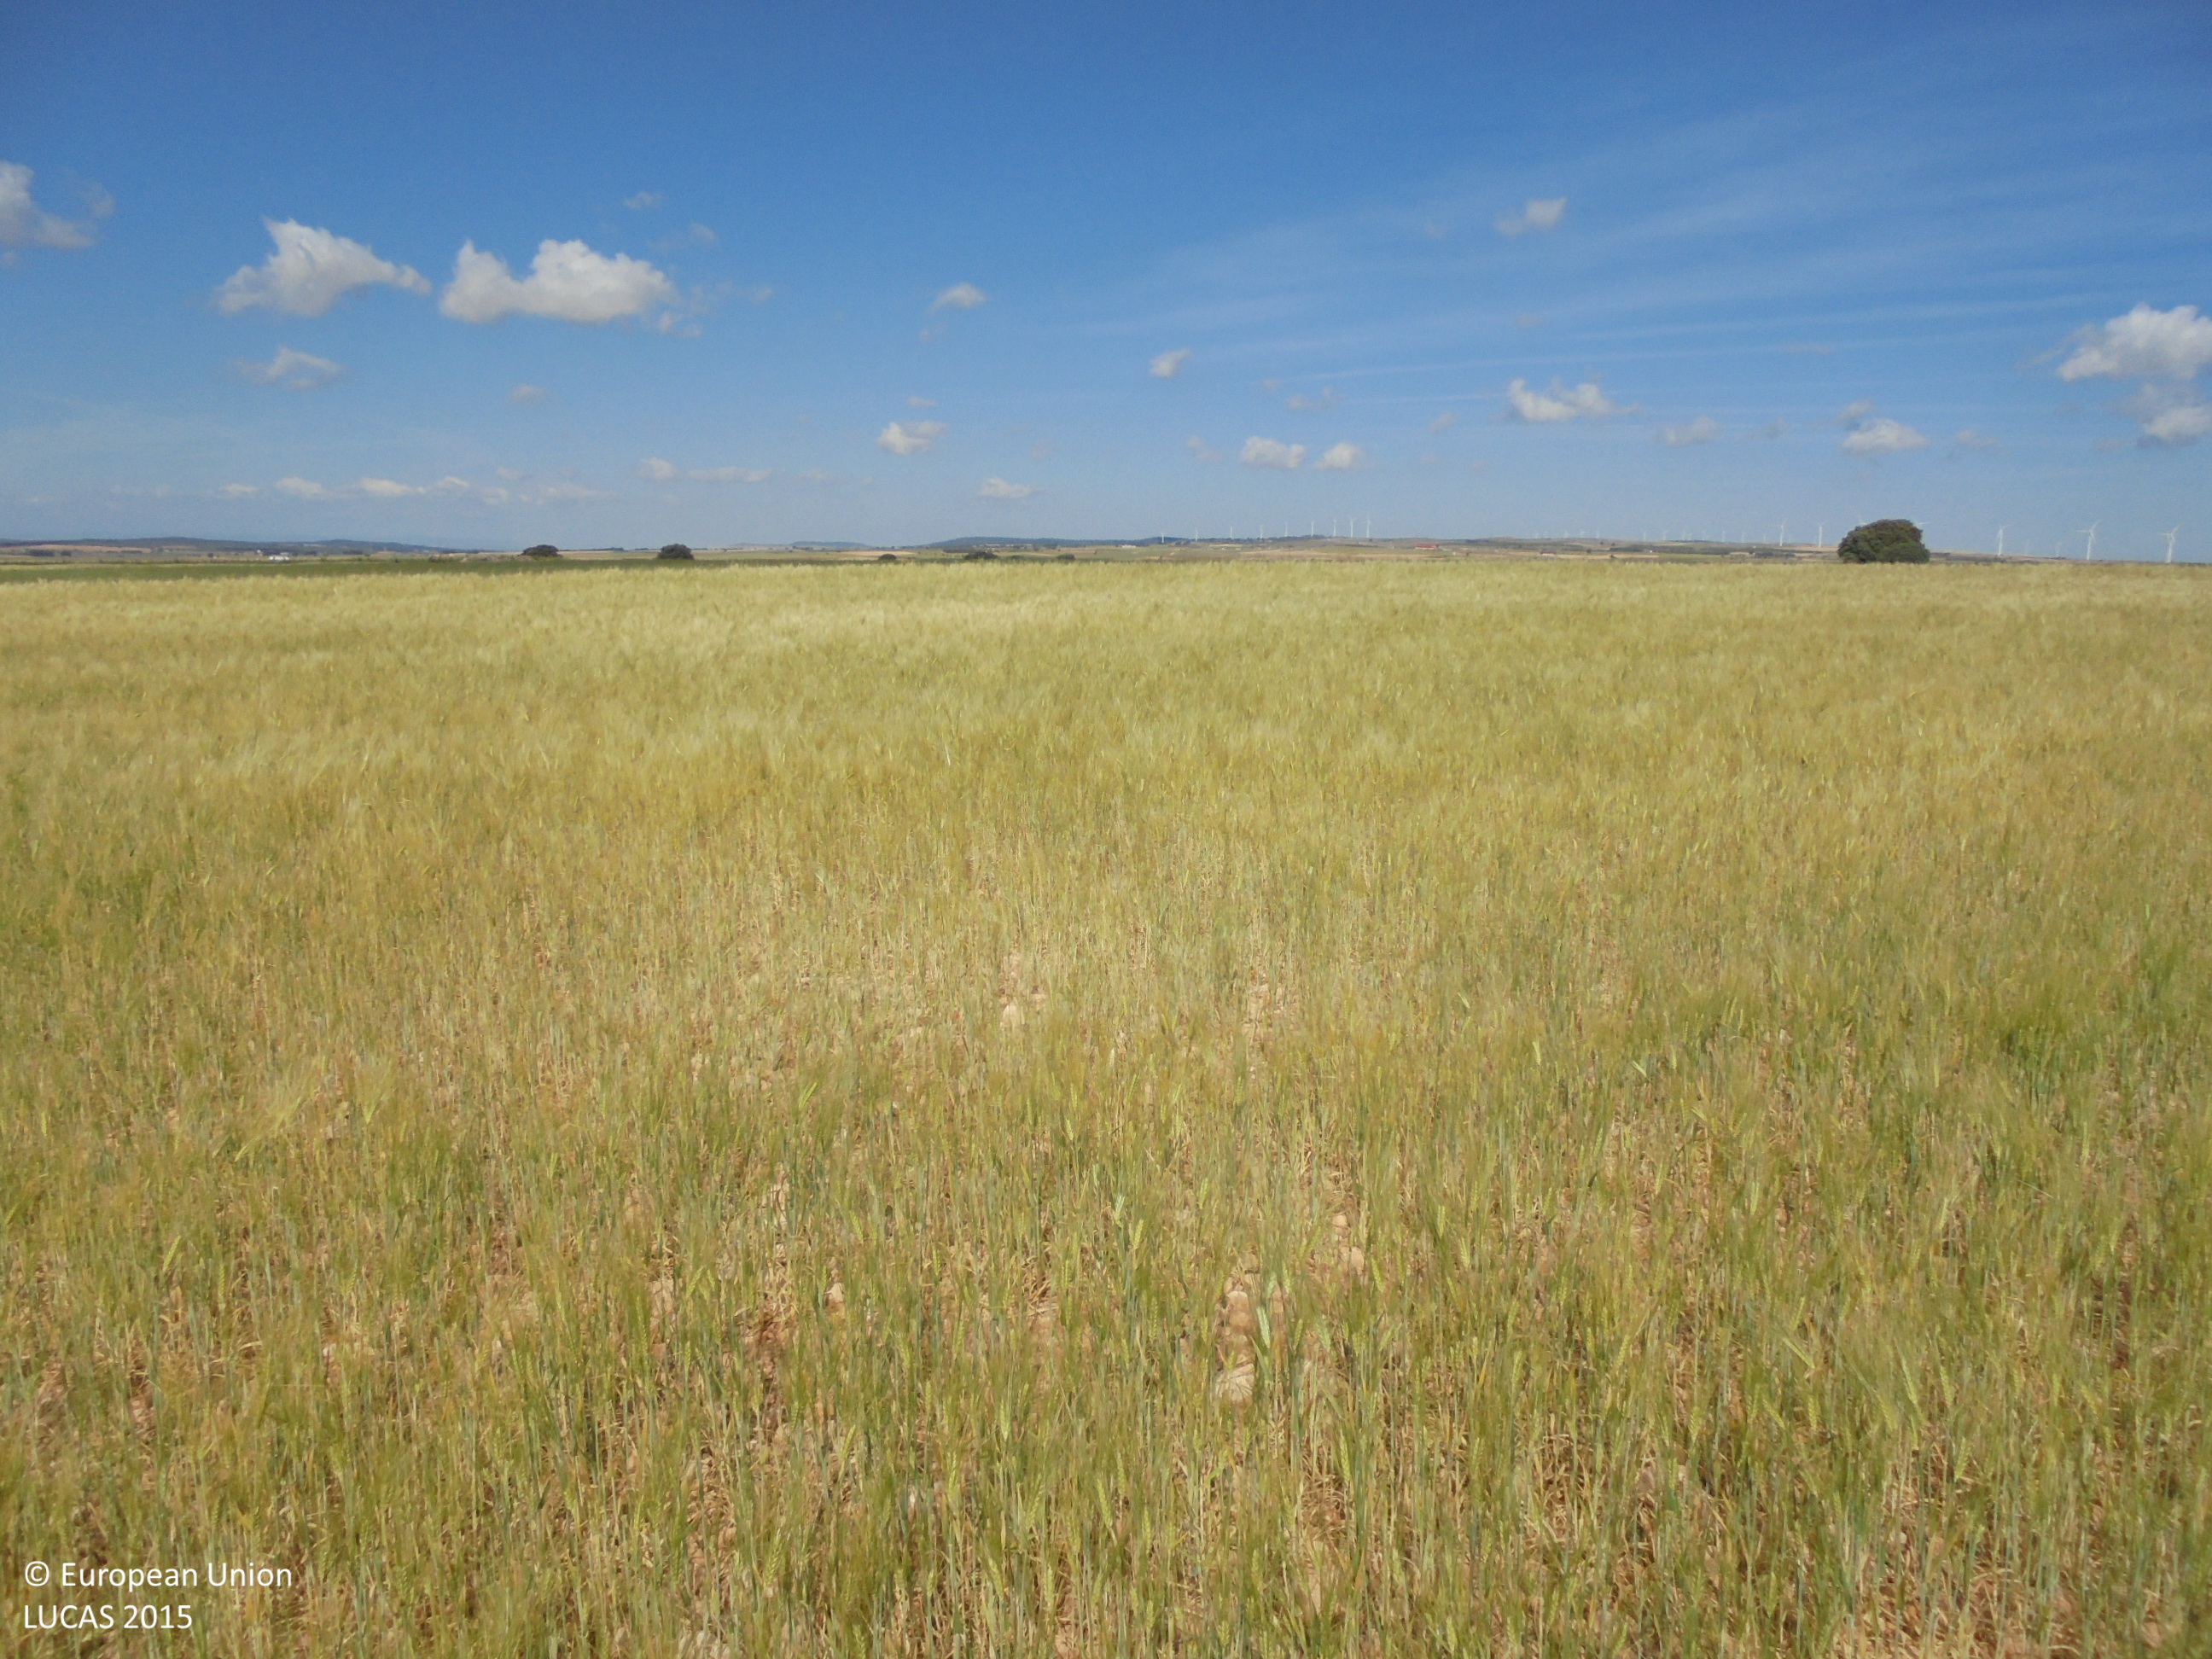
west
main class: Cropland
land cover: Barley
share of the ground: 25 - 50 %
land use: Agriculture (excluding fallow land and kitchen gardens)
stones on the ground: > 50 %
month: May
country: ES
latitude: 38.9492
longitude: -1.5013
